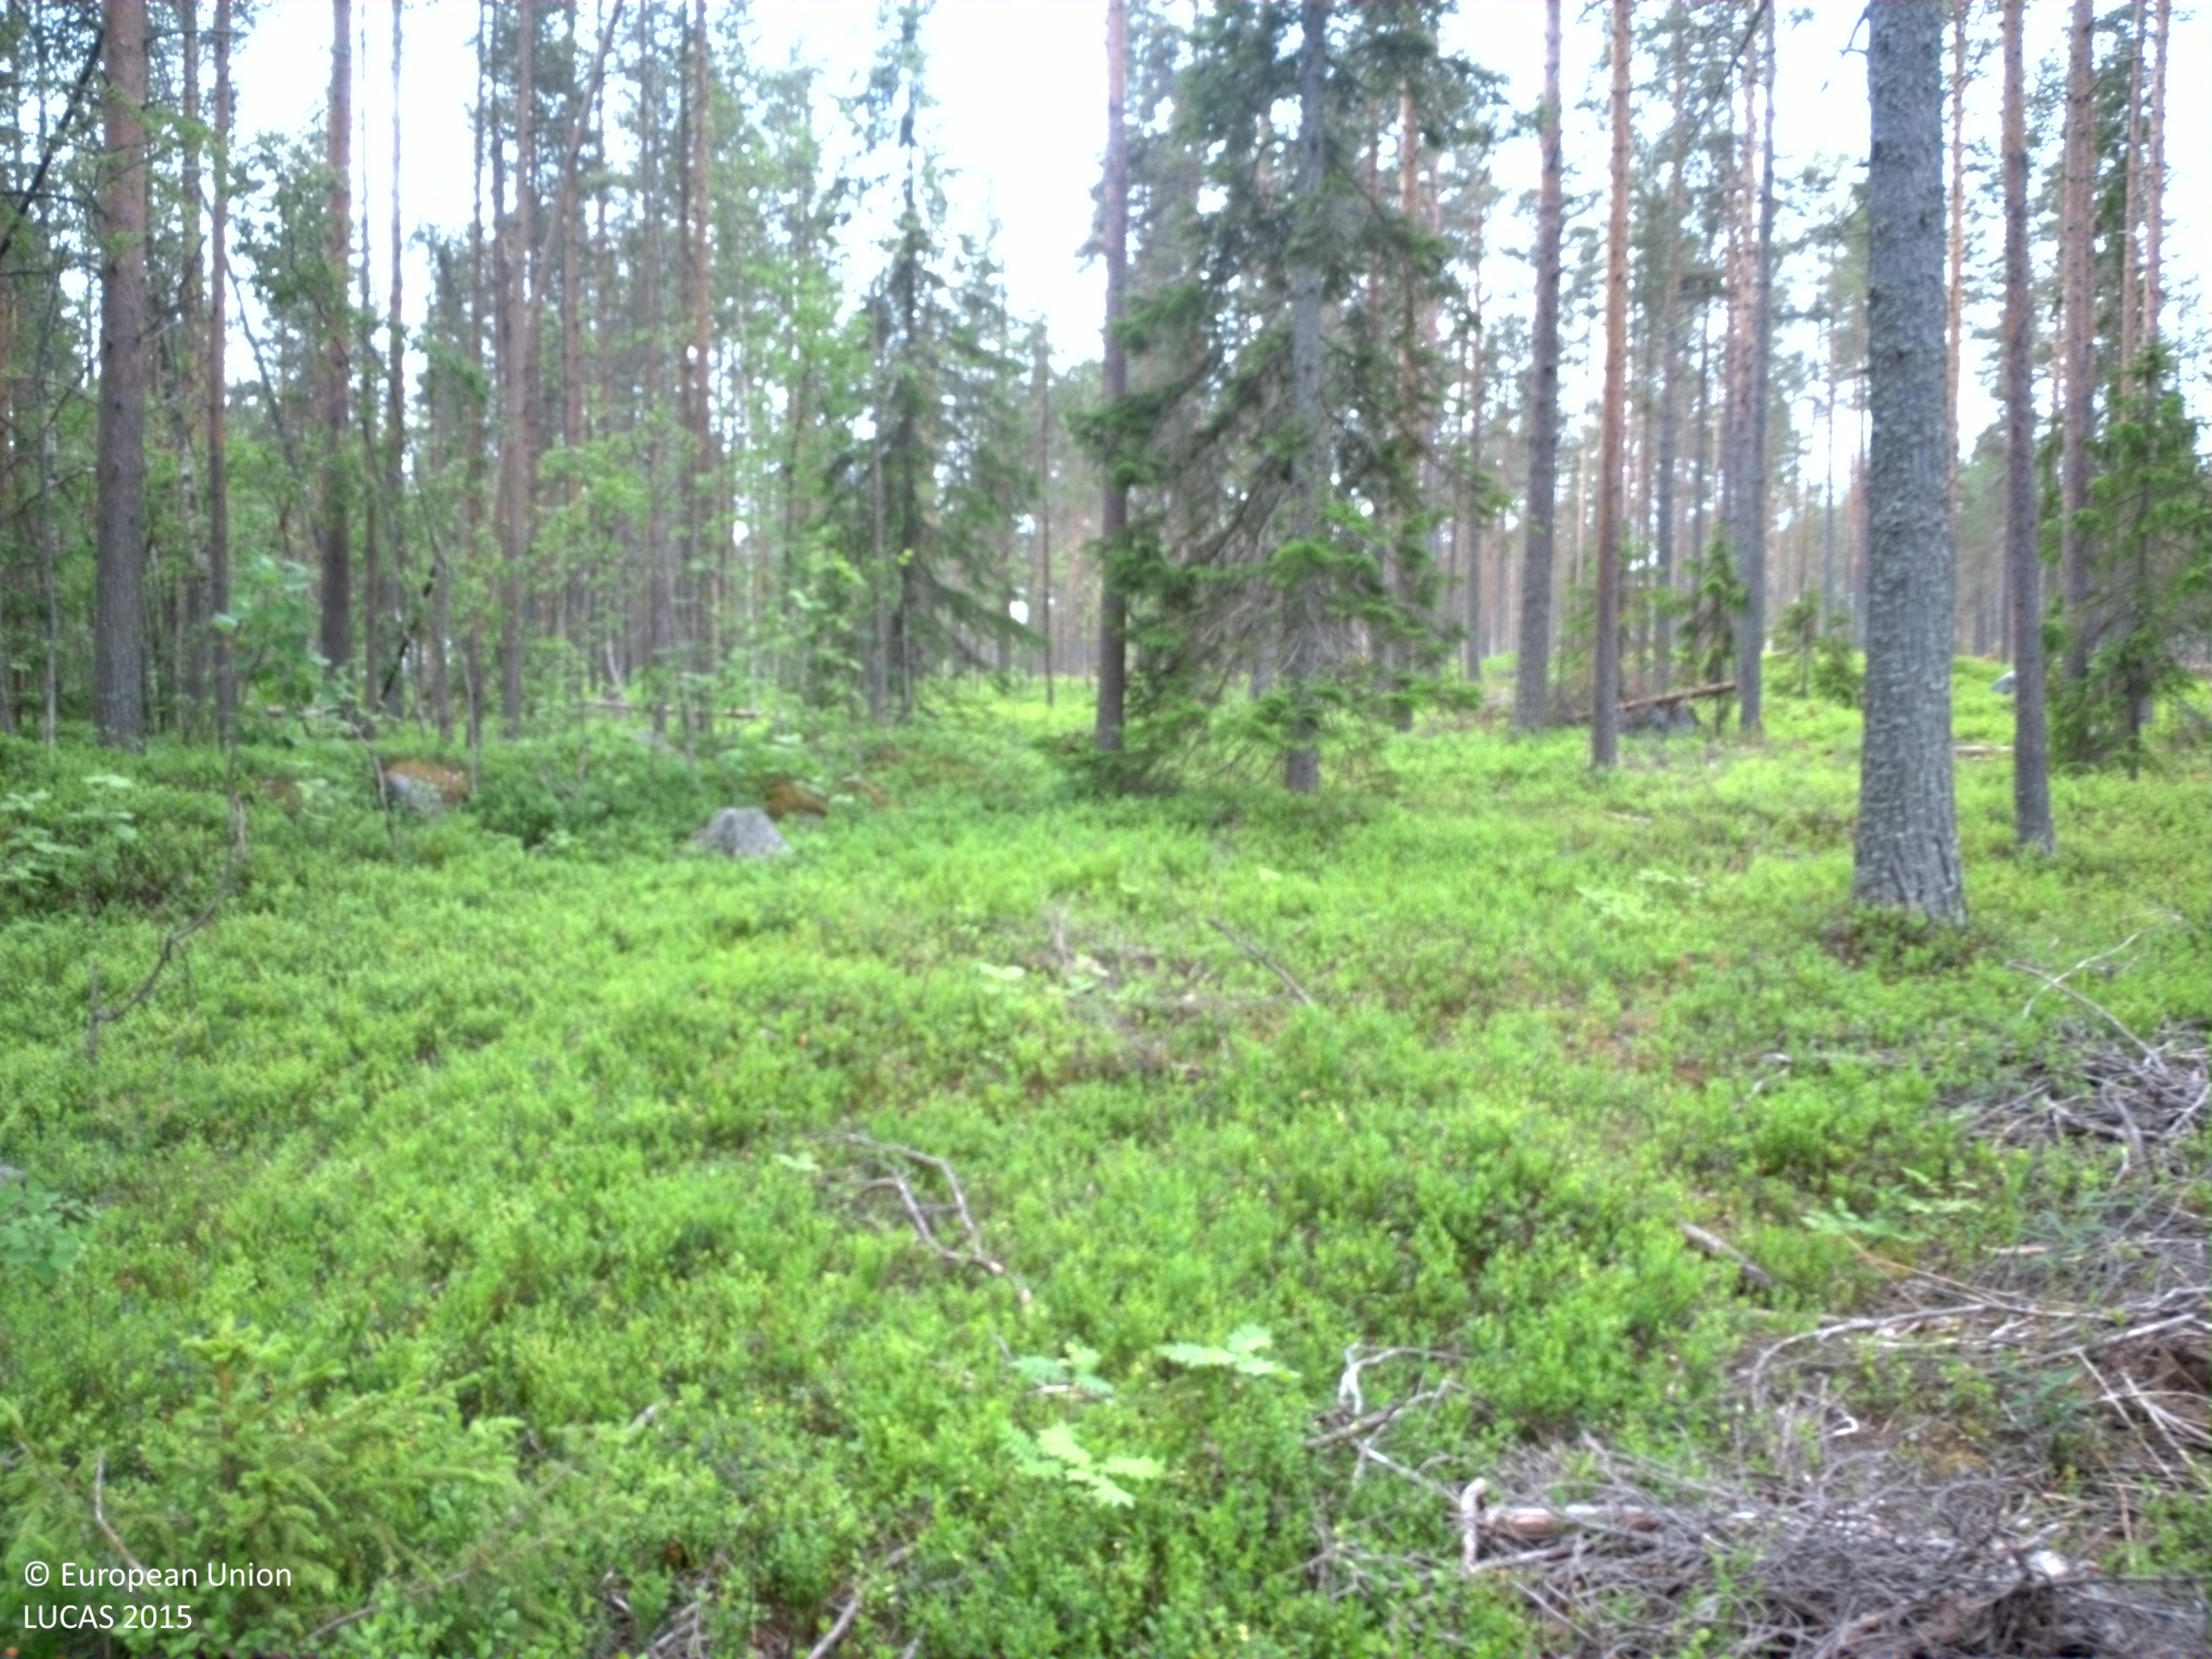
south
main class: Woodland
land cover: Pine dominated coniferous woodland
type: boreal forest
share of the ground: 25 - 50 %
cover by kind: shrubs 65 %, coniferous forest trees 30 %, broadleaved forest trees 5 %
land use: Forestry
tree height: > 5 m
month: July
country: SE
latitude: 64.4962
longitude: 20.9084
